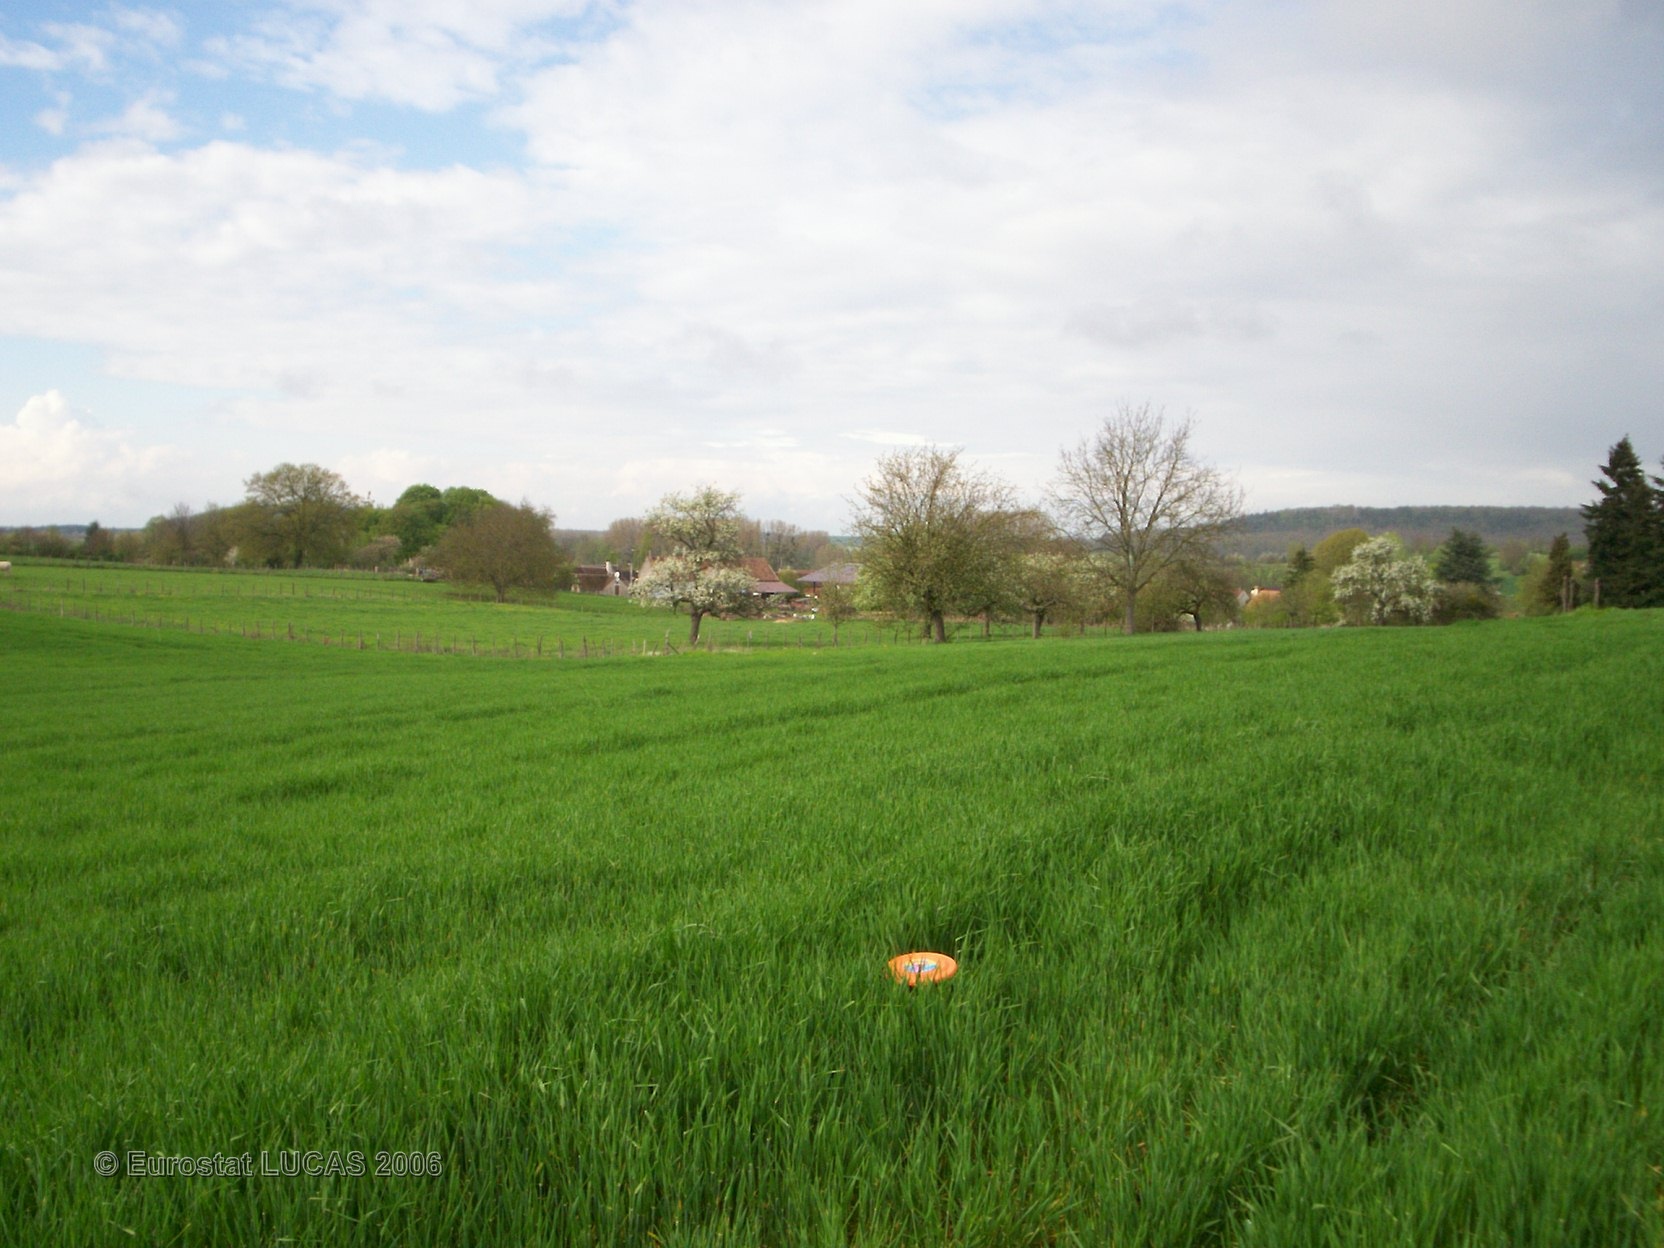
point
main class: Cropland
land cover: Barley
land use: Agriculture (excluding fallow land and kitchen gardens)
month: April
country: FR
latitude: 48.2863
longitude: 2.9435
